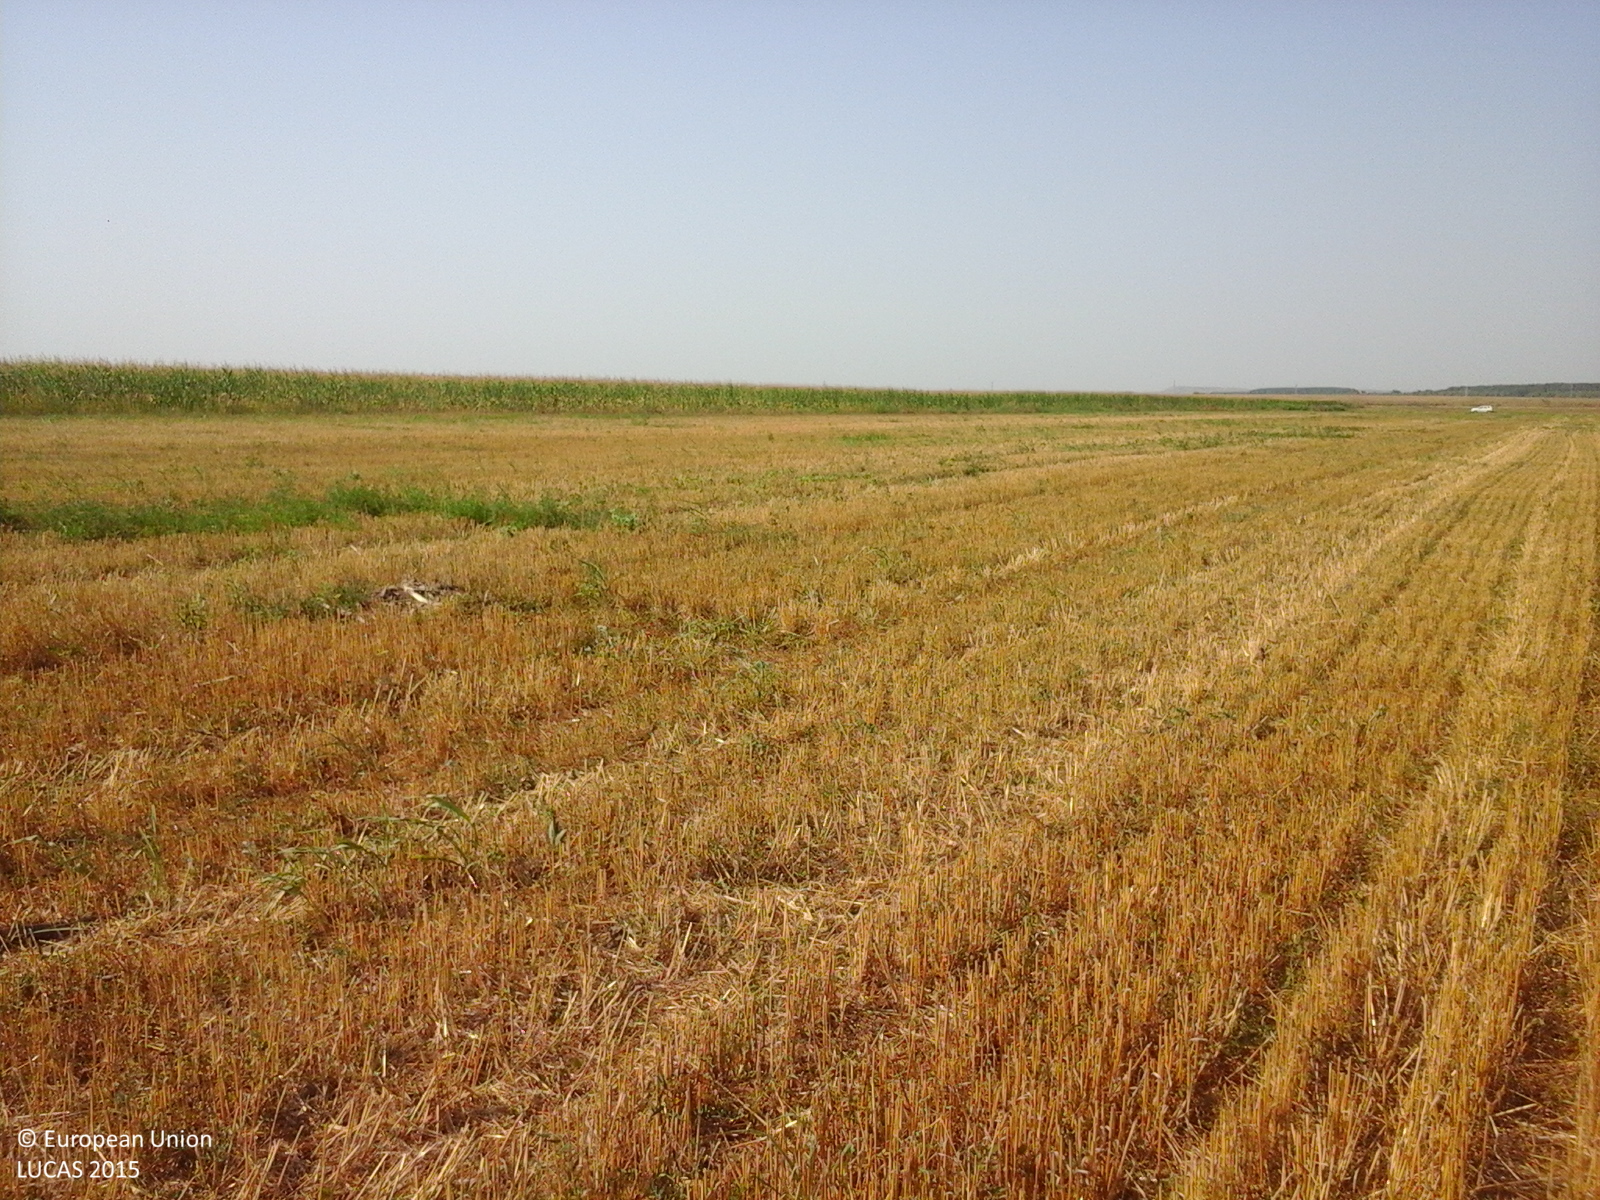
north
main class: Cropland
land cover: Common wheat
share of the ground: 25 - 50 %
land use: Agriculture (excluding fallow land and kitchen gardens)
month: August
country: RO
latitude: 44.8991
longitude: 28.1103
